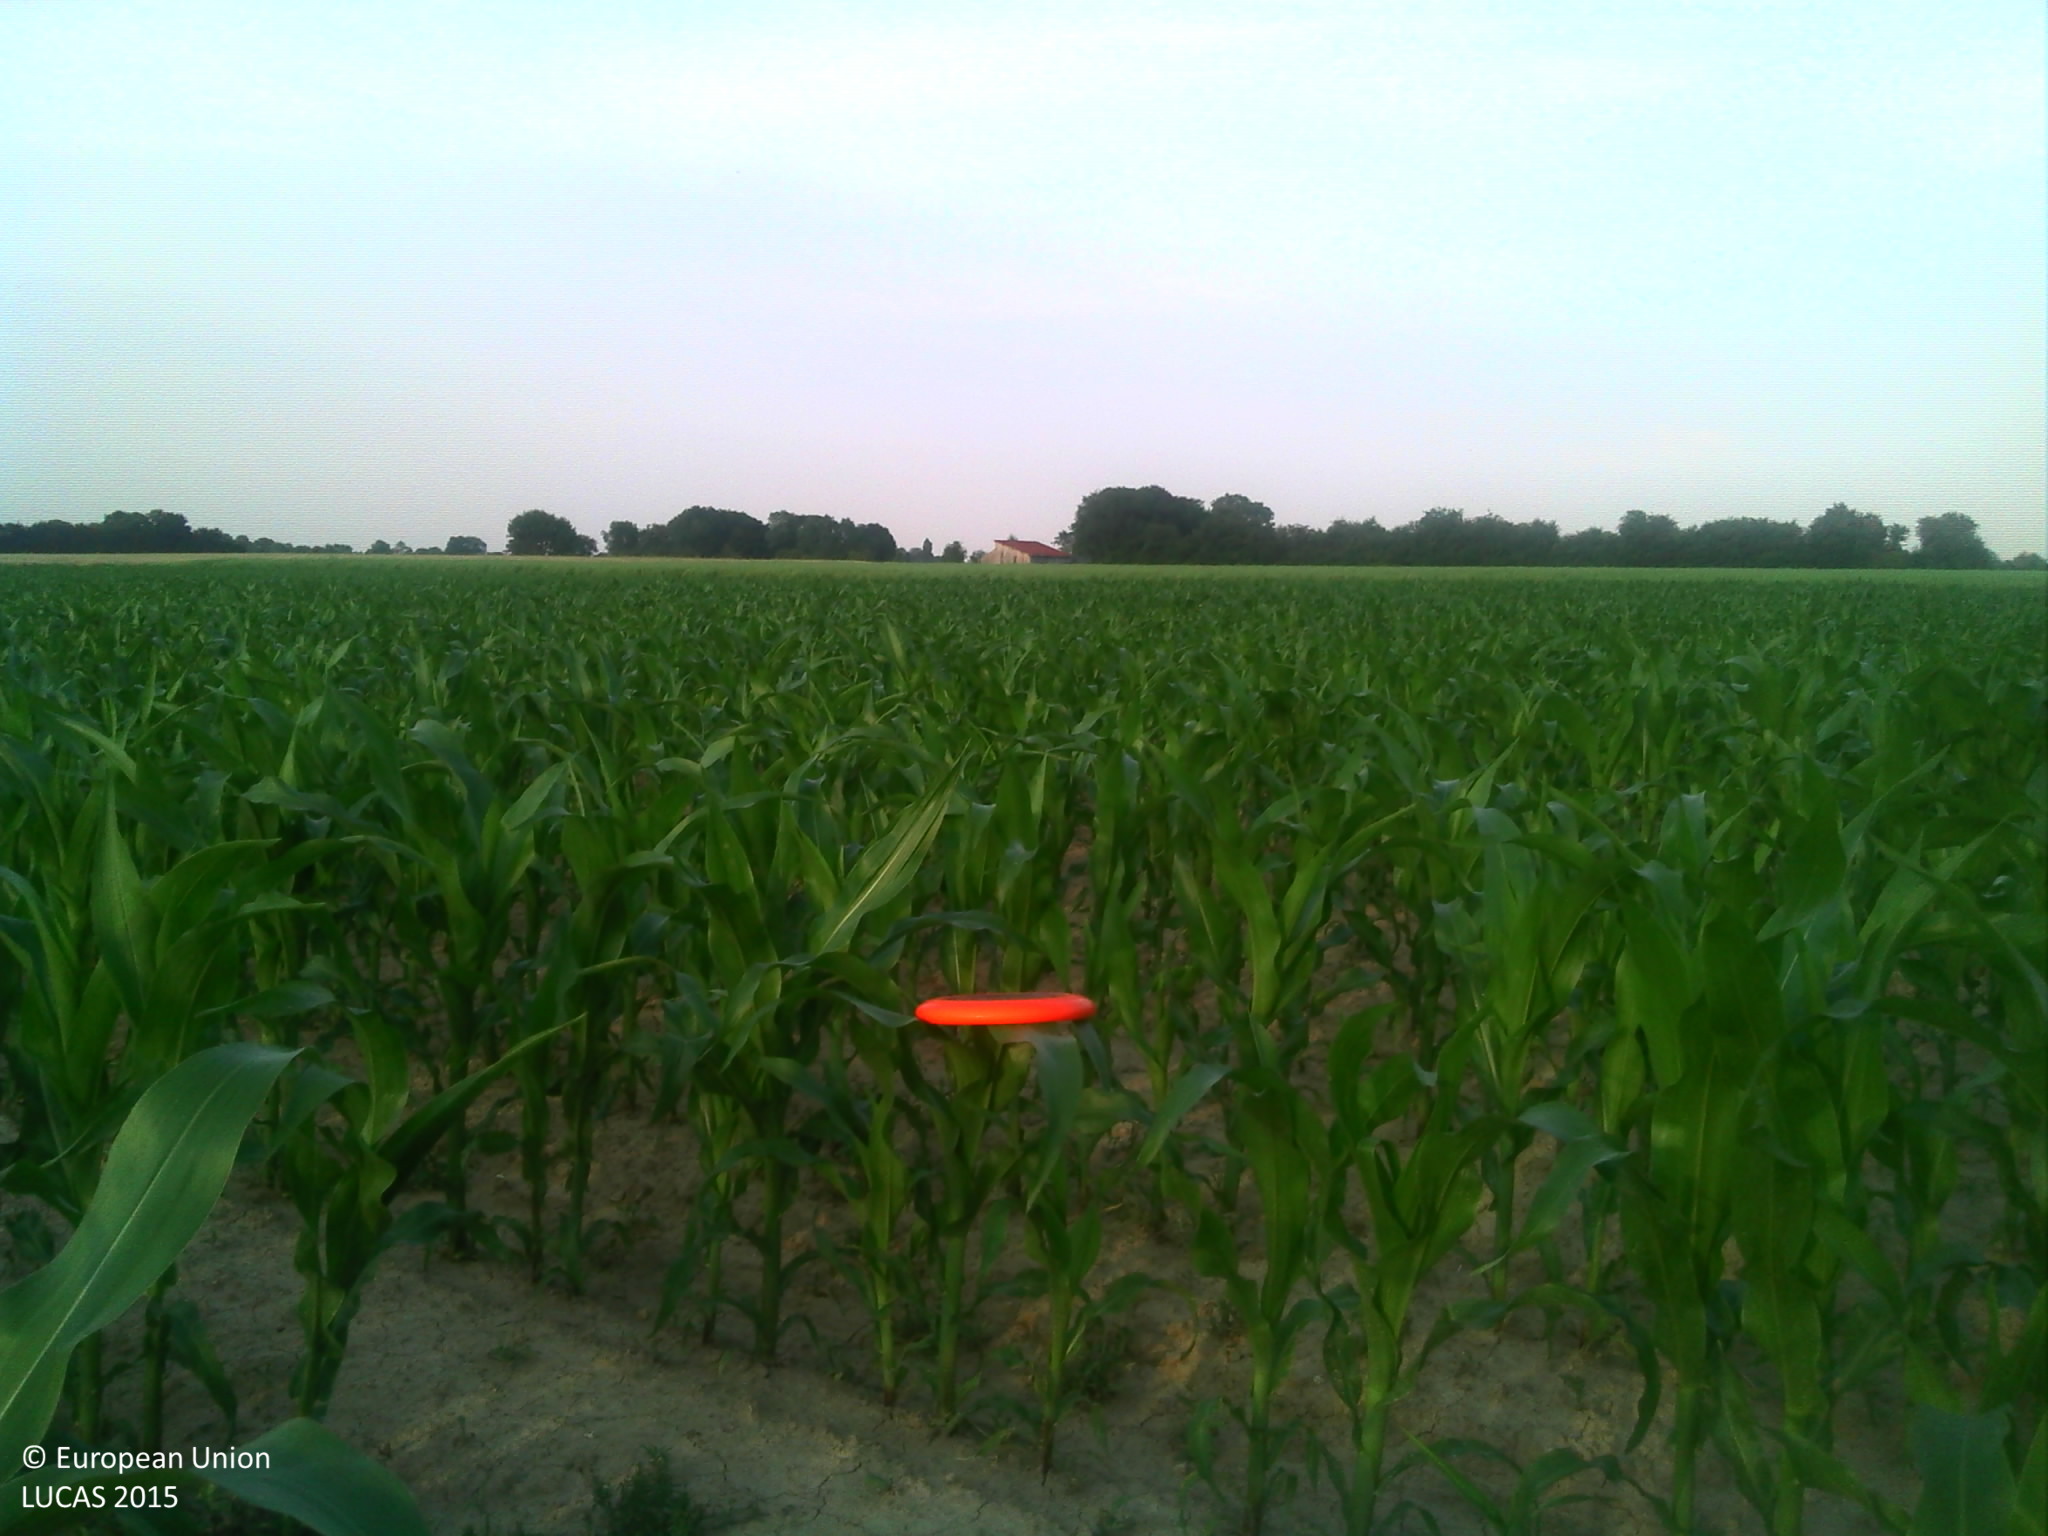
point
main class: Cropland
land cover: Maize
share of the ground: 50 - 75 %
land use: Agriculture (excluding fallow land and kitchen gardens)
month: July
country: FR
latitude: 48.8918
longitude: 0.4124
